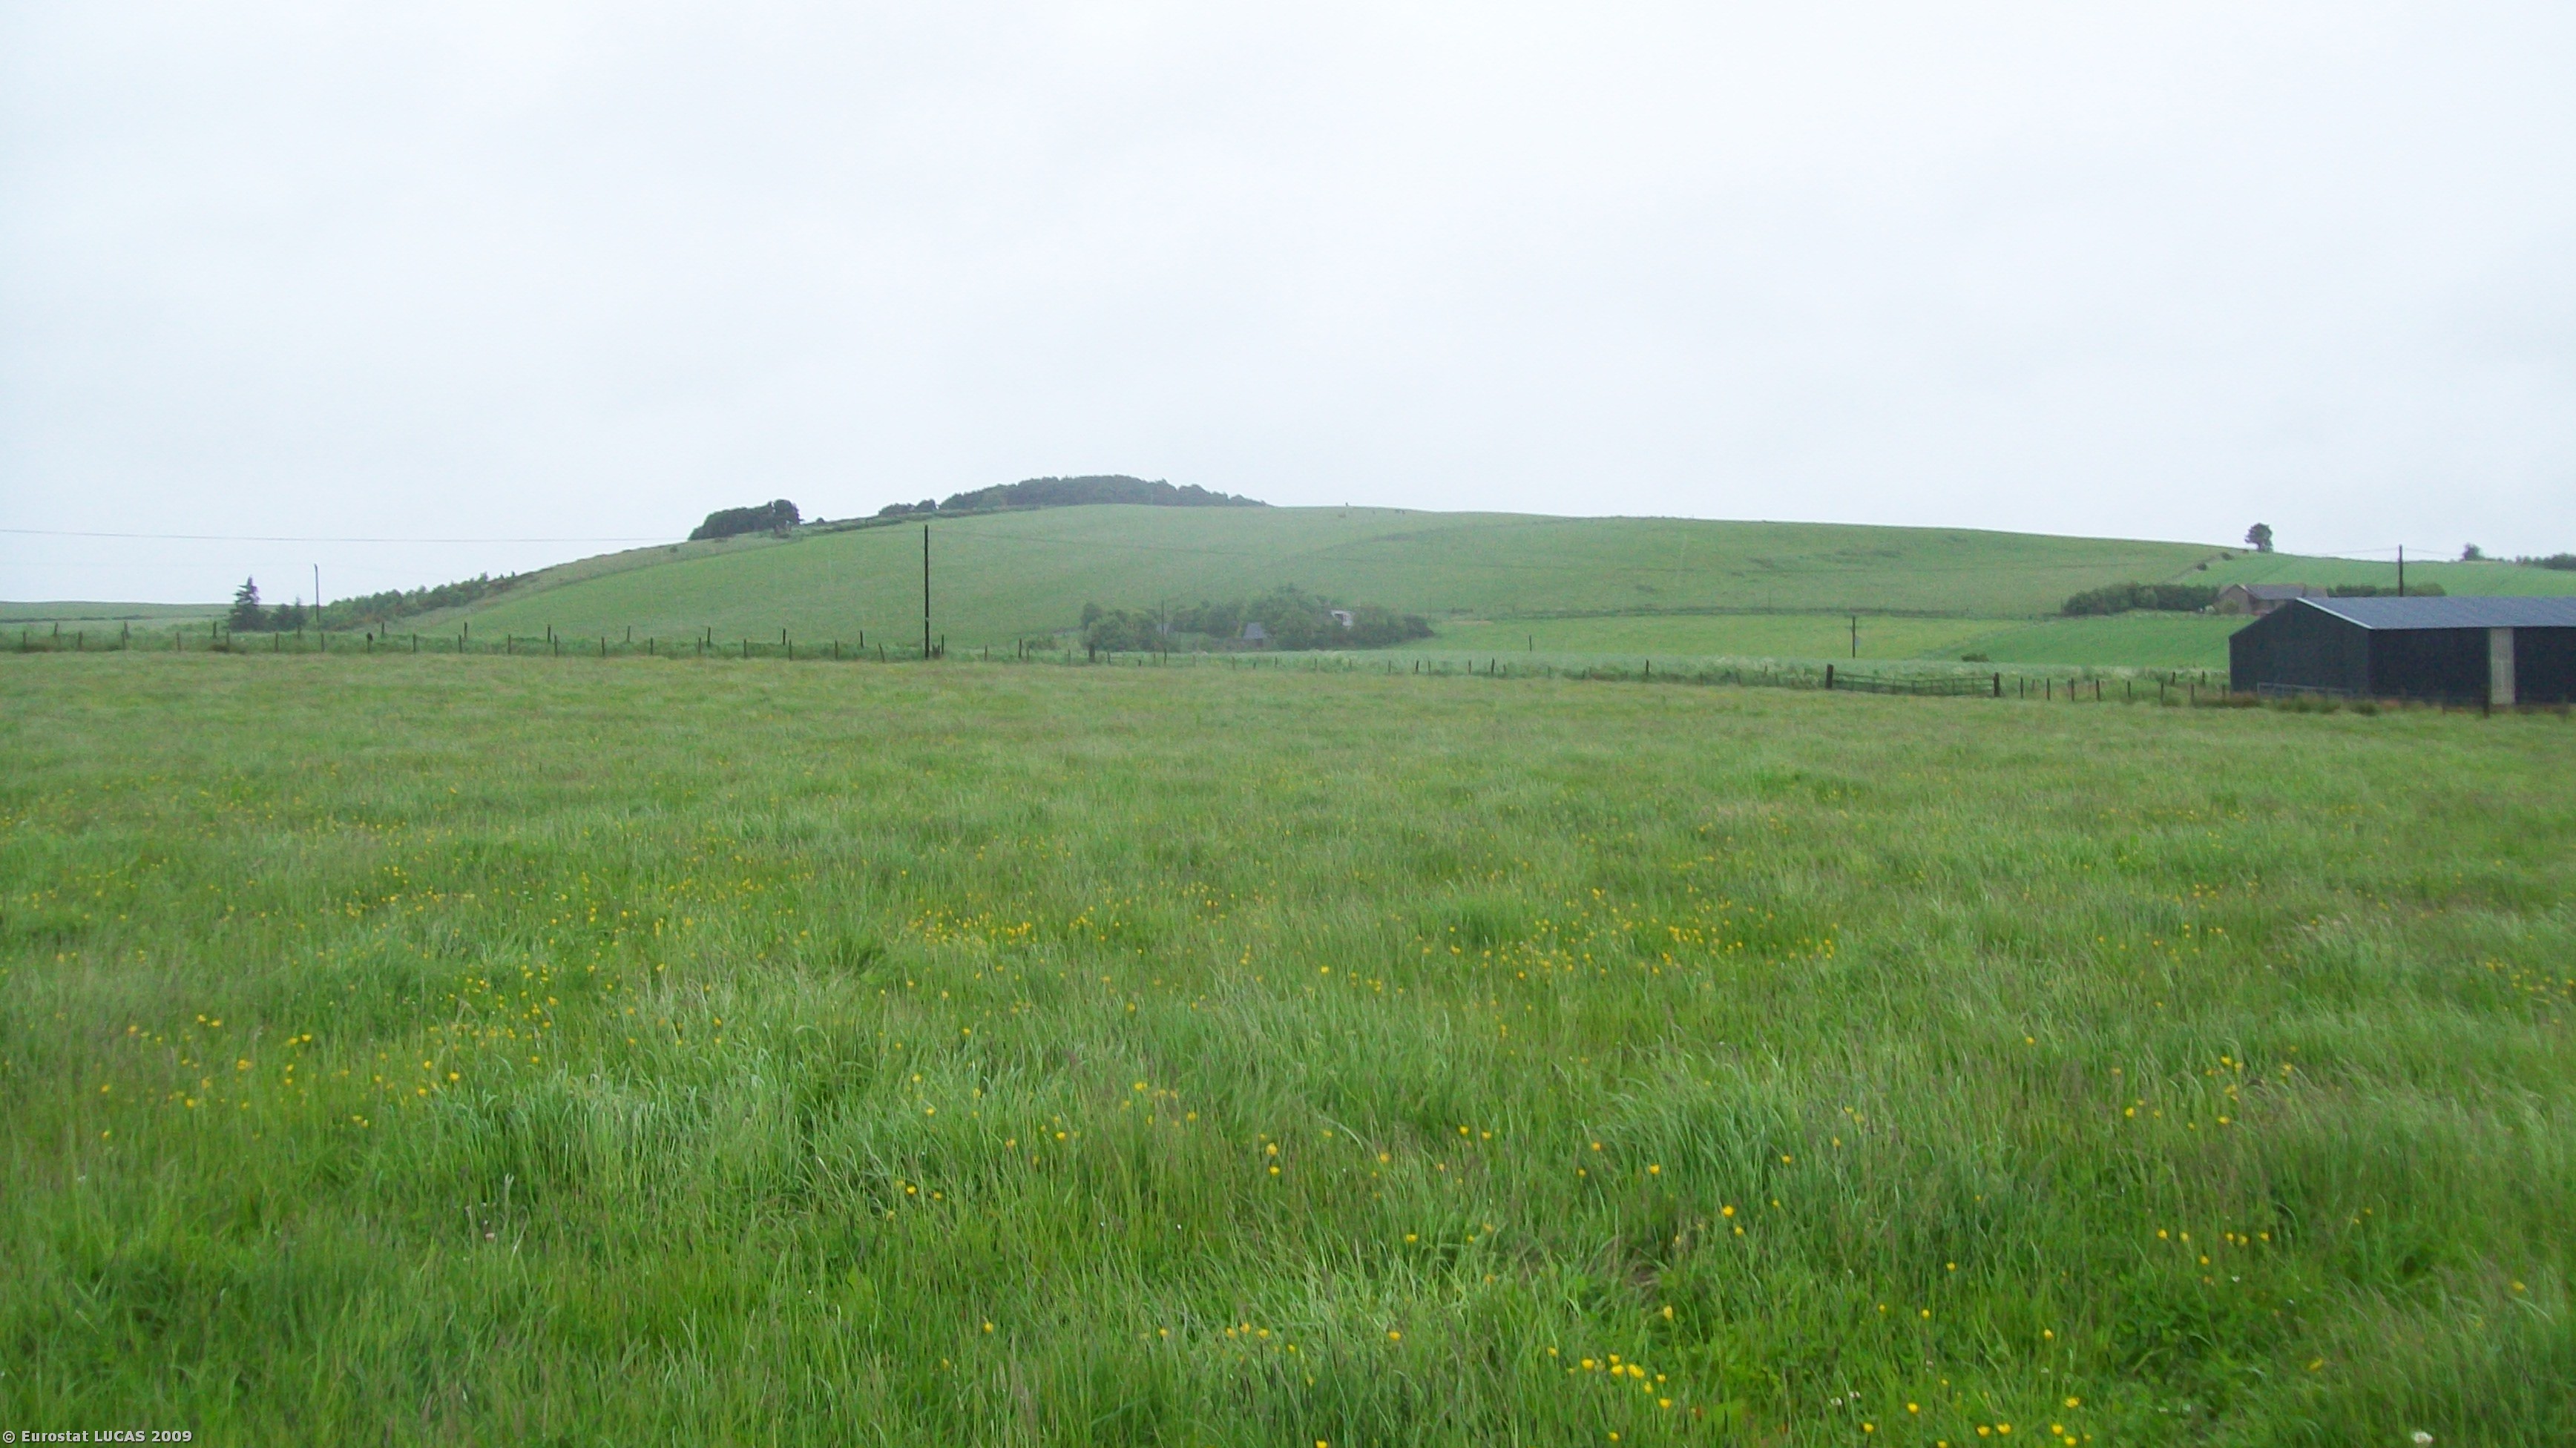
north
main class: Grassland
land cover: Grassland without tree/shrub cover
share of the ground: > 75 %
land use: Agriculture (excluding fallow land and kitchen gardens)
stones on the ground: 10 - 25 %
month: June
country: GB
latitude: 57.5887
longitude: -2.5828
